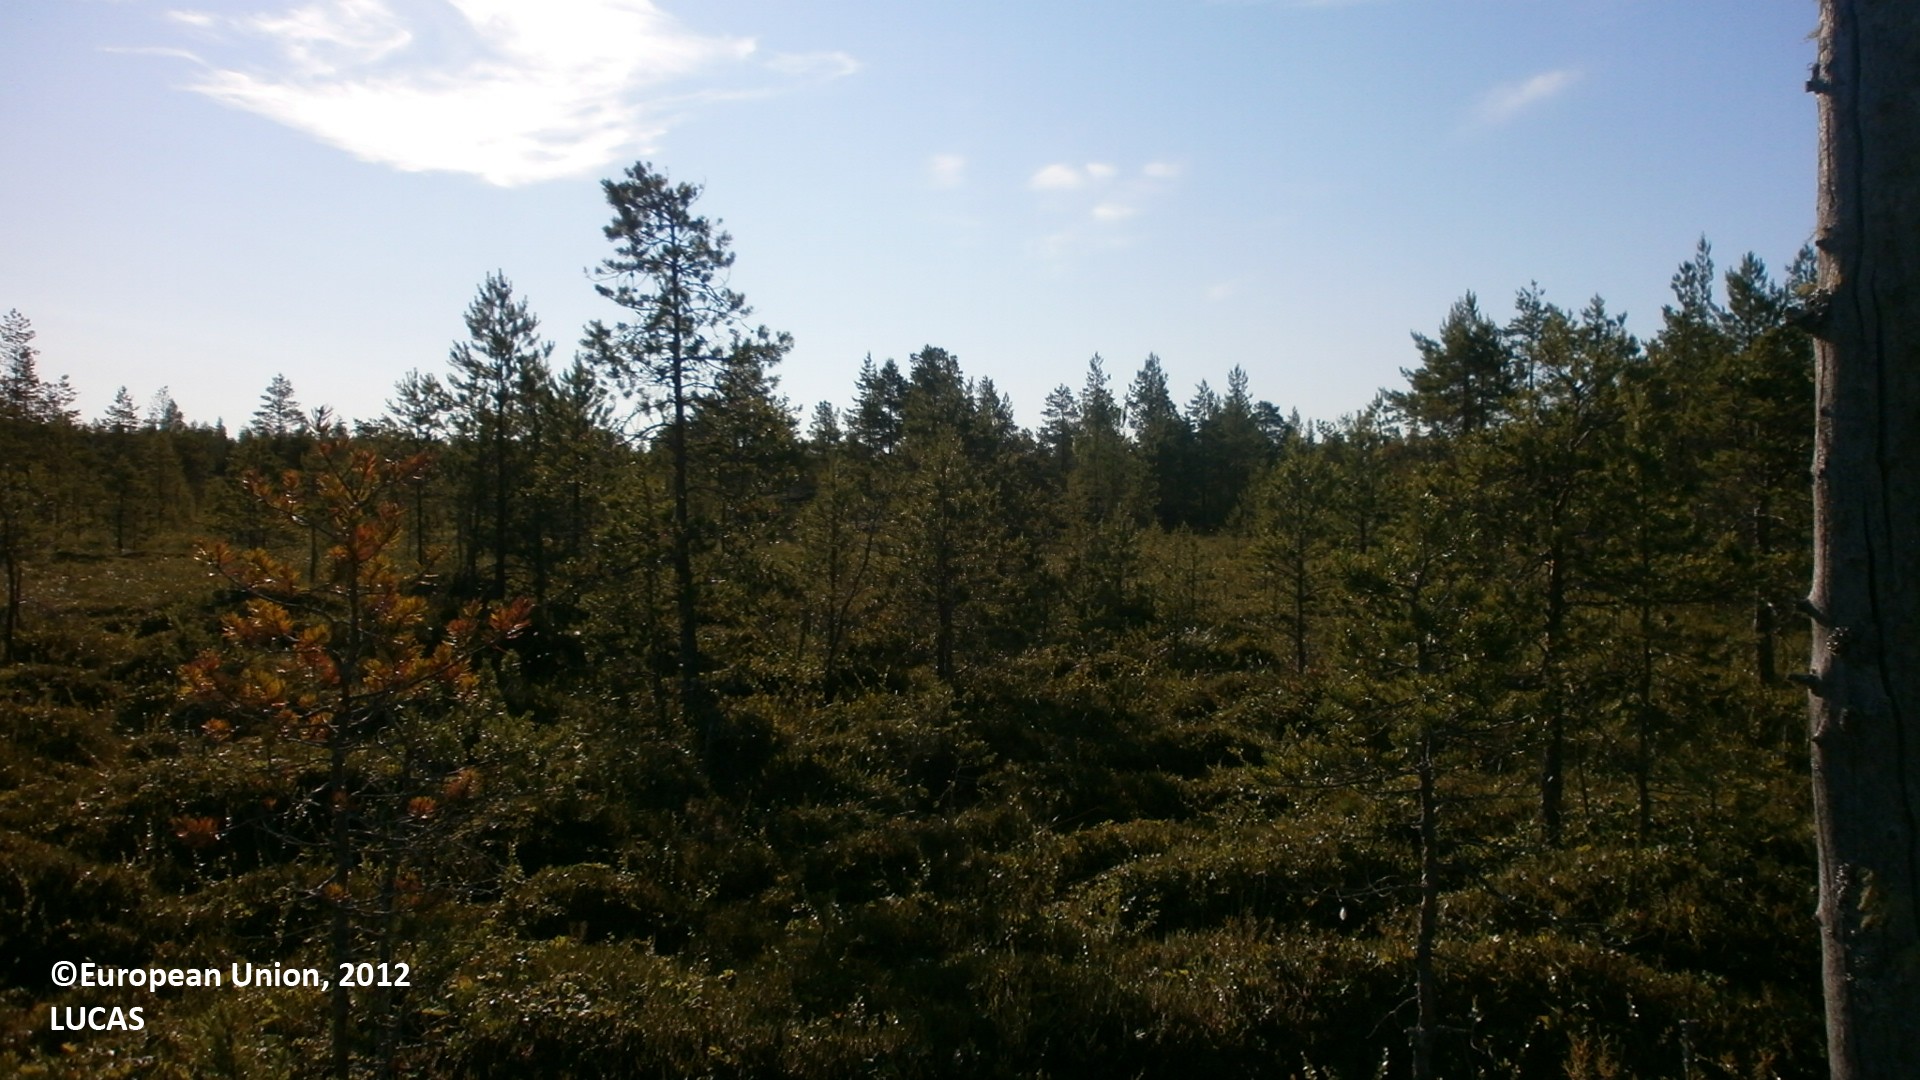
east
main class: Woodland
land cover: Pine dominated coniferous woodland
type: boreal forest
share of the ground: 10 - 25 %
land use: Semi-natural and natural areas not in use
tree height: < 5 m
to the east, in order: Pine dominated coniferous woodland; Peatbogs; Pine dominated coniferous woodland; Peatbogs; Pine dominated coniferous woodland; Tracks; Pine dominated coniferous woodland
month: July
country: FI
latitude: 64.0200
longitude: 24.1237
